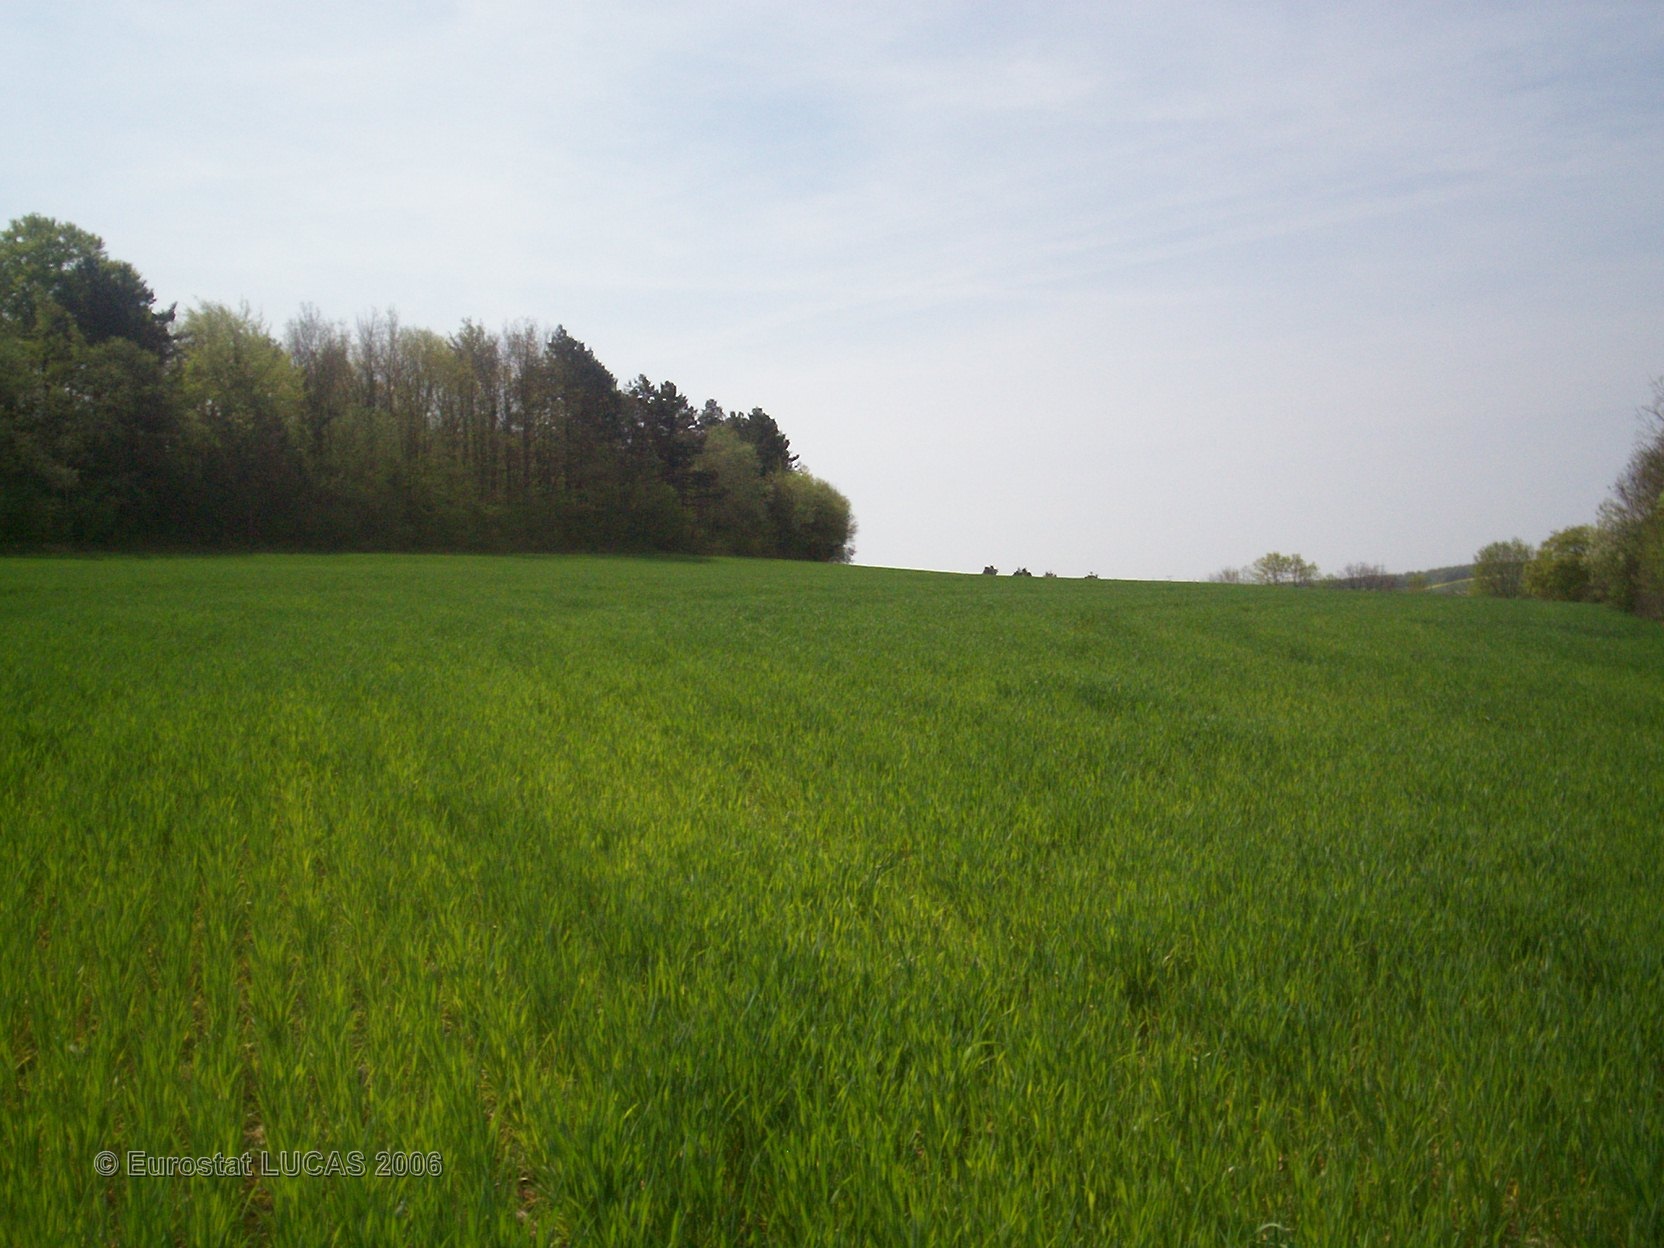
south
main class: Cropland
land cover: Common wheat
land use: Agriculture (excluding fallow land and kitchen gardens)
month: May
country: FR
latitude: 47.4805
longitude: 4.6515
